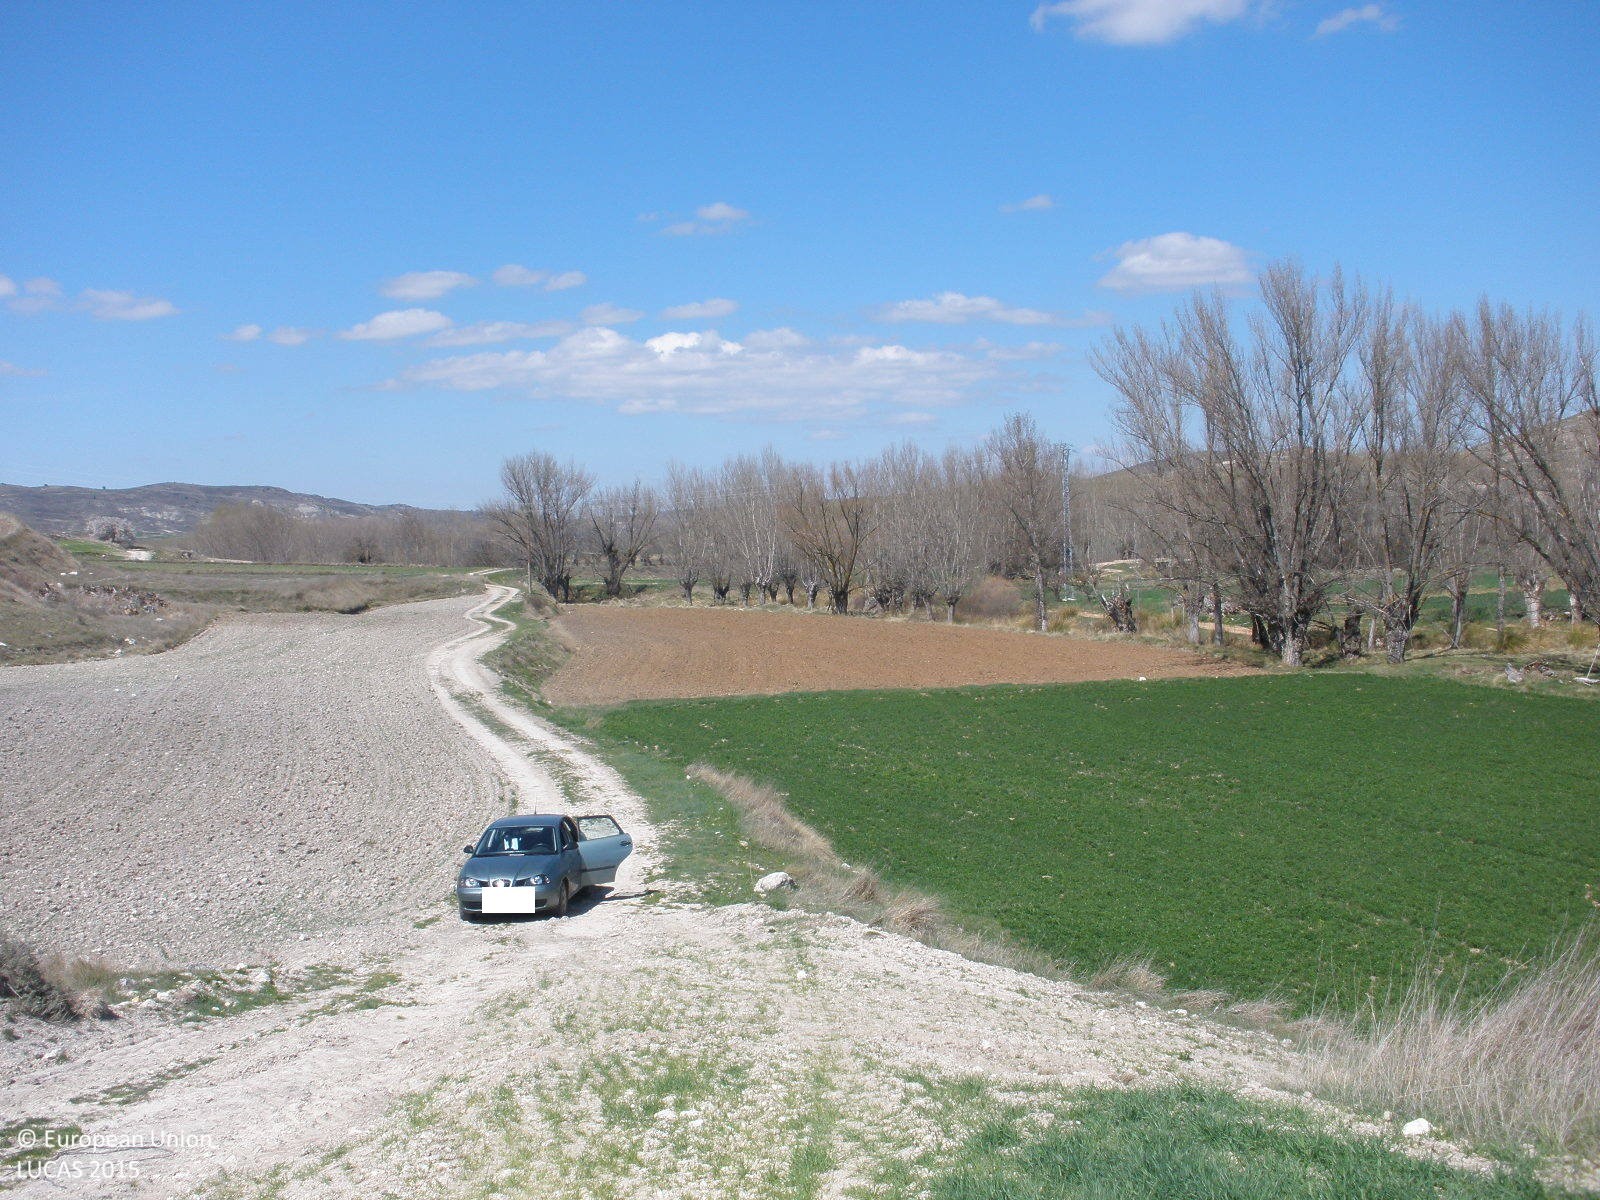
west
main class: Cropland
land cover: Barley
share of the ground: 50 - 75 %
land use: Agriculture (excluding fallow land and kitchen gardens)
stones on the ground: 10 - 25 %
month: April
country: ES
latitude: 40.8898
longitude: -1.1374
